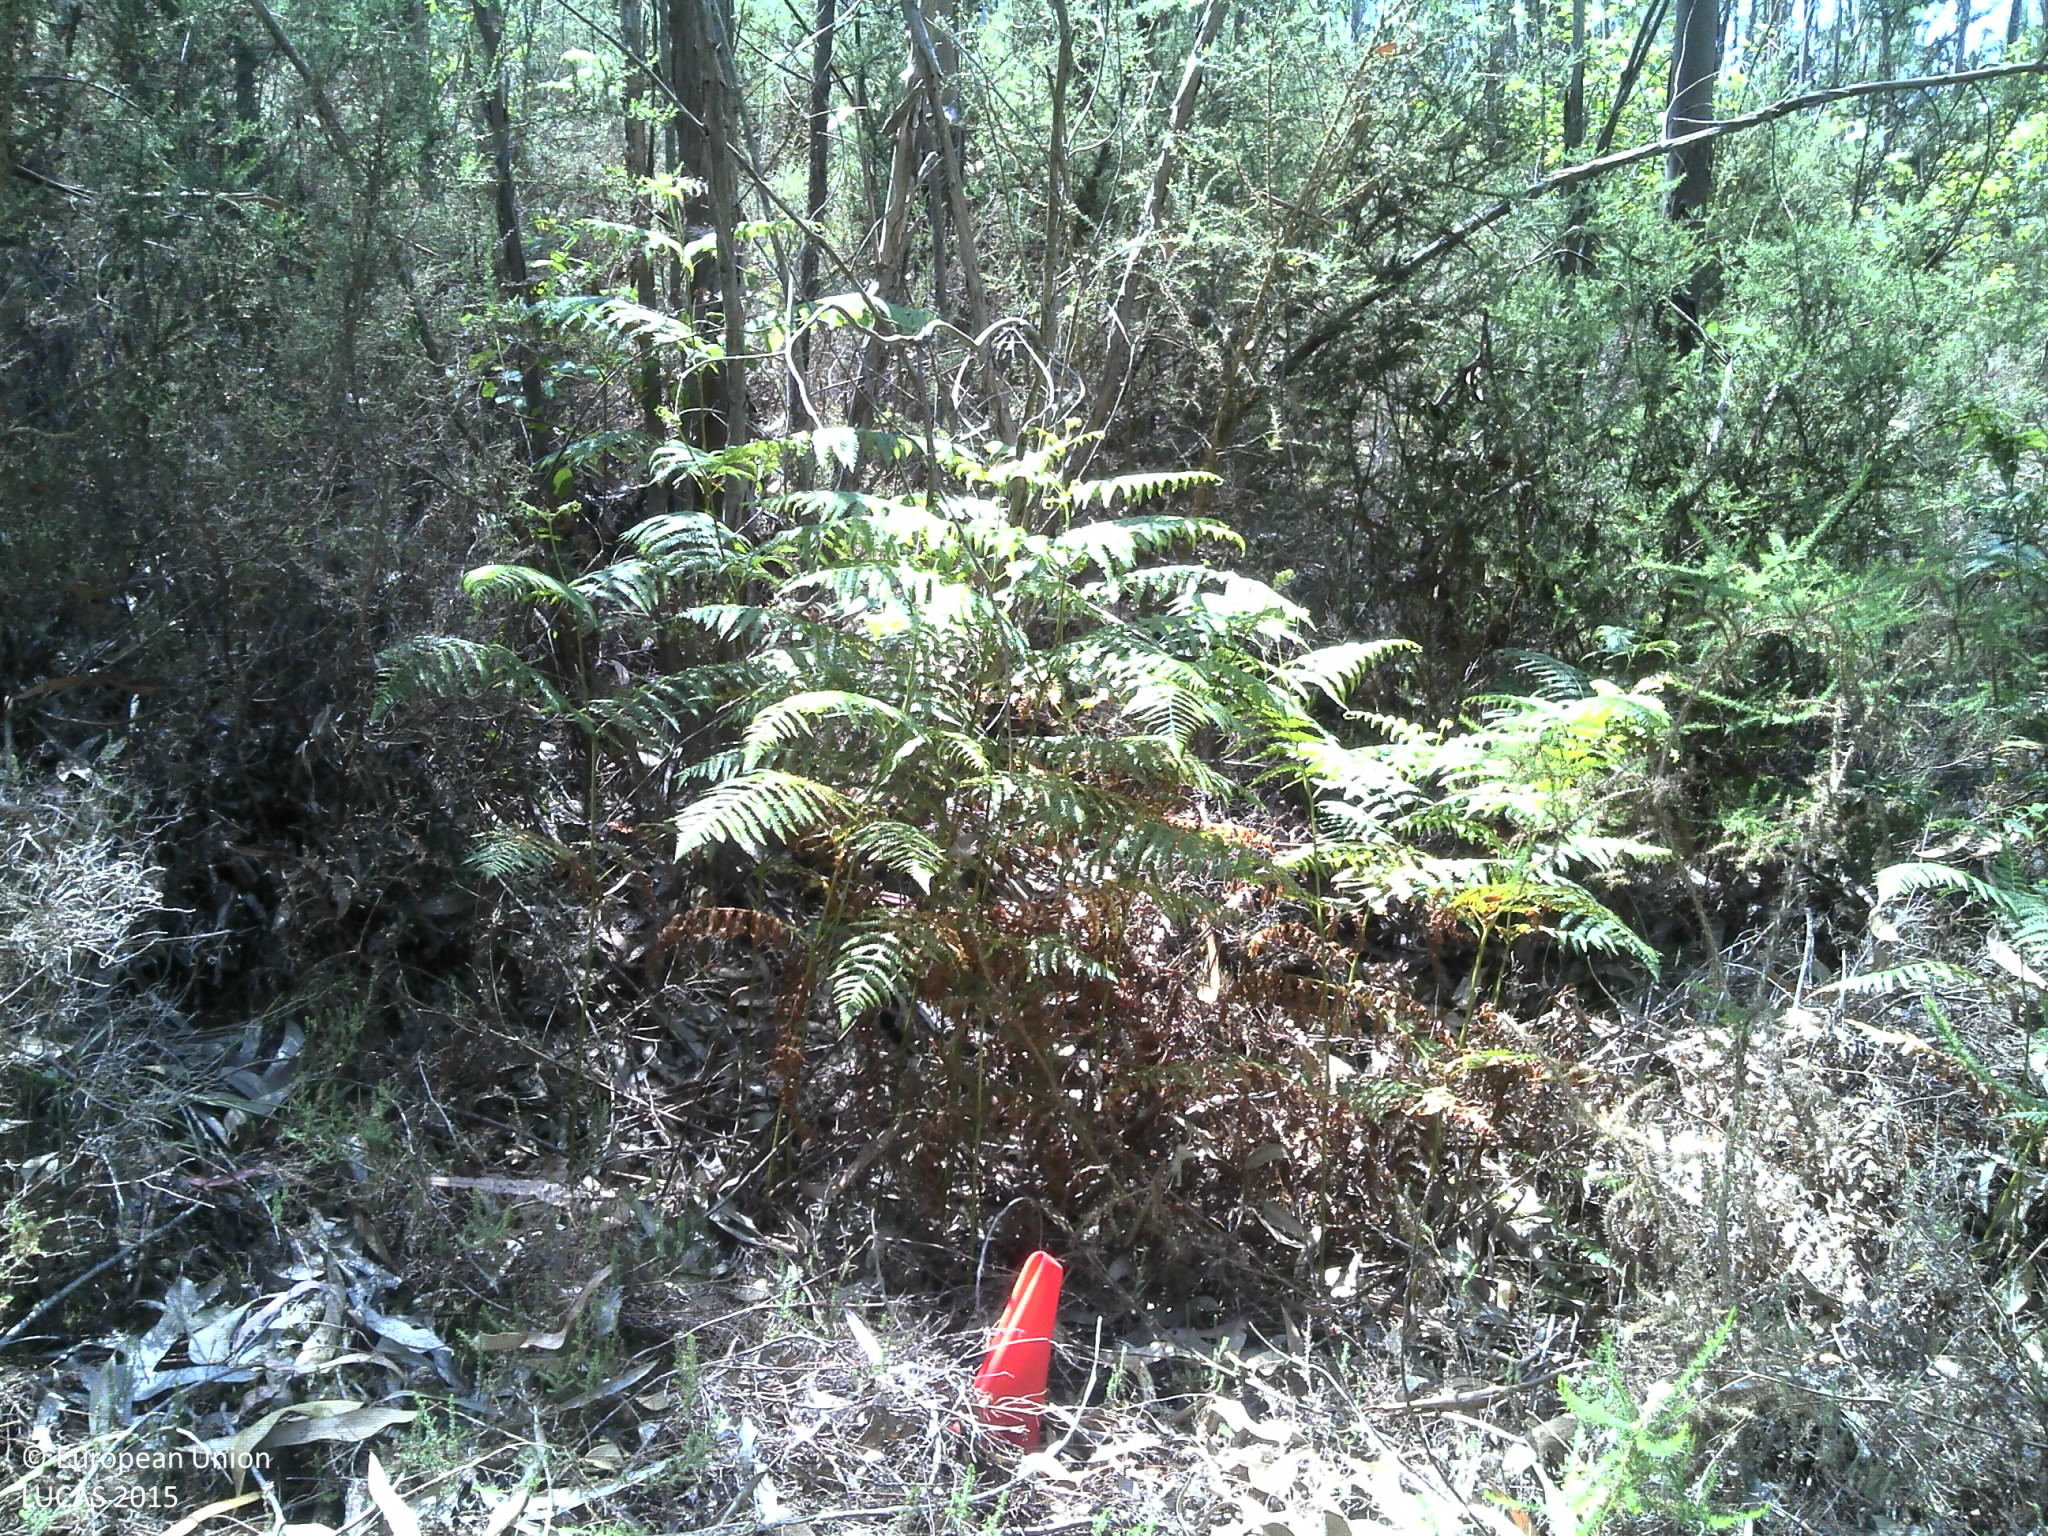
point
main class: Woodland
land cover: Broadleaved woodland
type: exotic forest
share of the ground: 50 - 75 %
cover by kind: broadleaved forest trees 55 %, shrubs 30 %, herbaceous plants 10 %, unconsolidated bare surface 5 %
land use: Forestry
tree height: > 5 m
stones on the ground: < 10 %
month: June
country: PT
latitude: 40.7495
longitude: -8.3904
